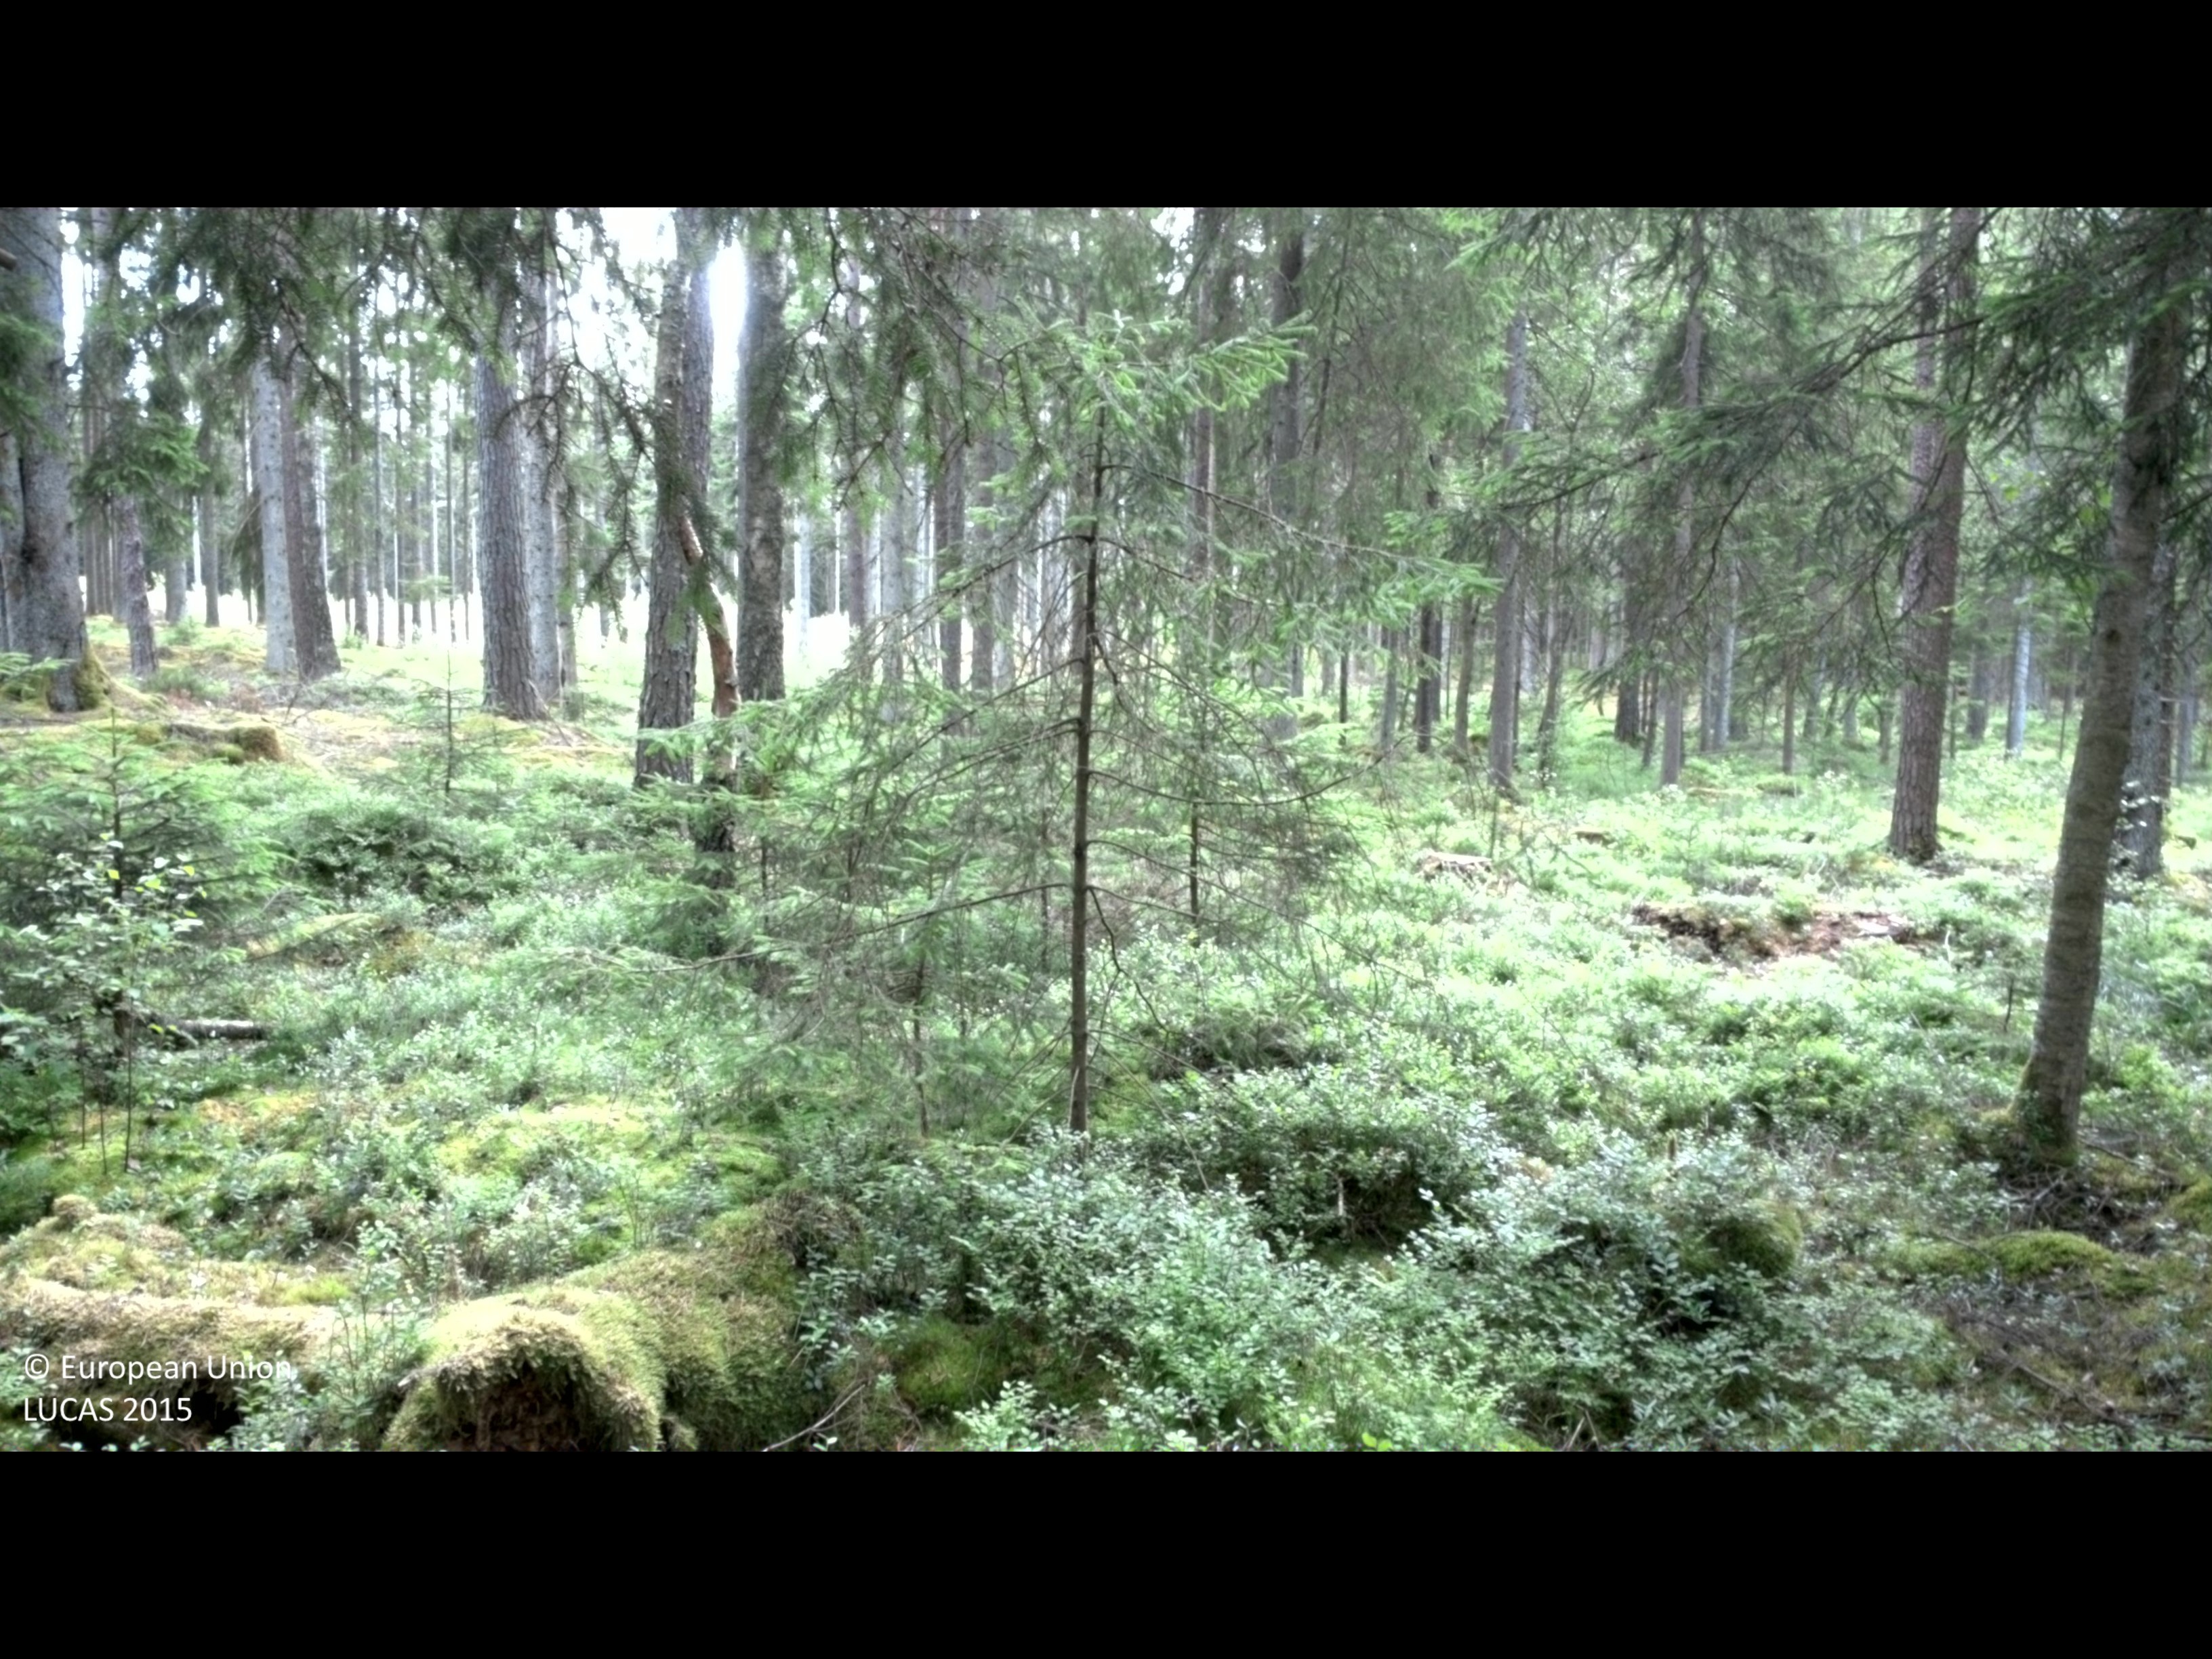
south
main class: Woodland
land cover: Spruce dominated coniferous woodland
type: boreal forest
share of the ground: 50 - 75 %
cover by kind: coniferous forest trees 65 %, shrubs 30 %, lichens and mosses 5 %
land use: Forestry
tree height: > 5 m
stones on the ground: < 10 %
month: July
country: SE
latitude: 56.4930
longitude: 13.7490
